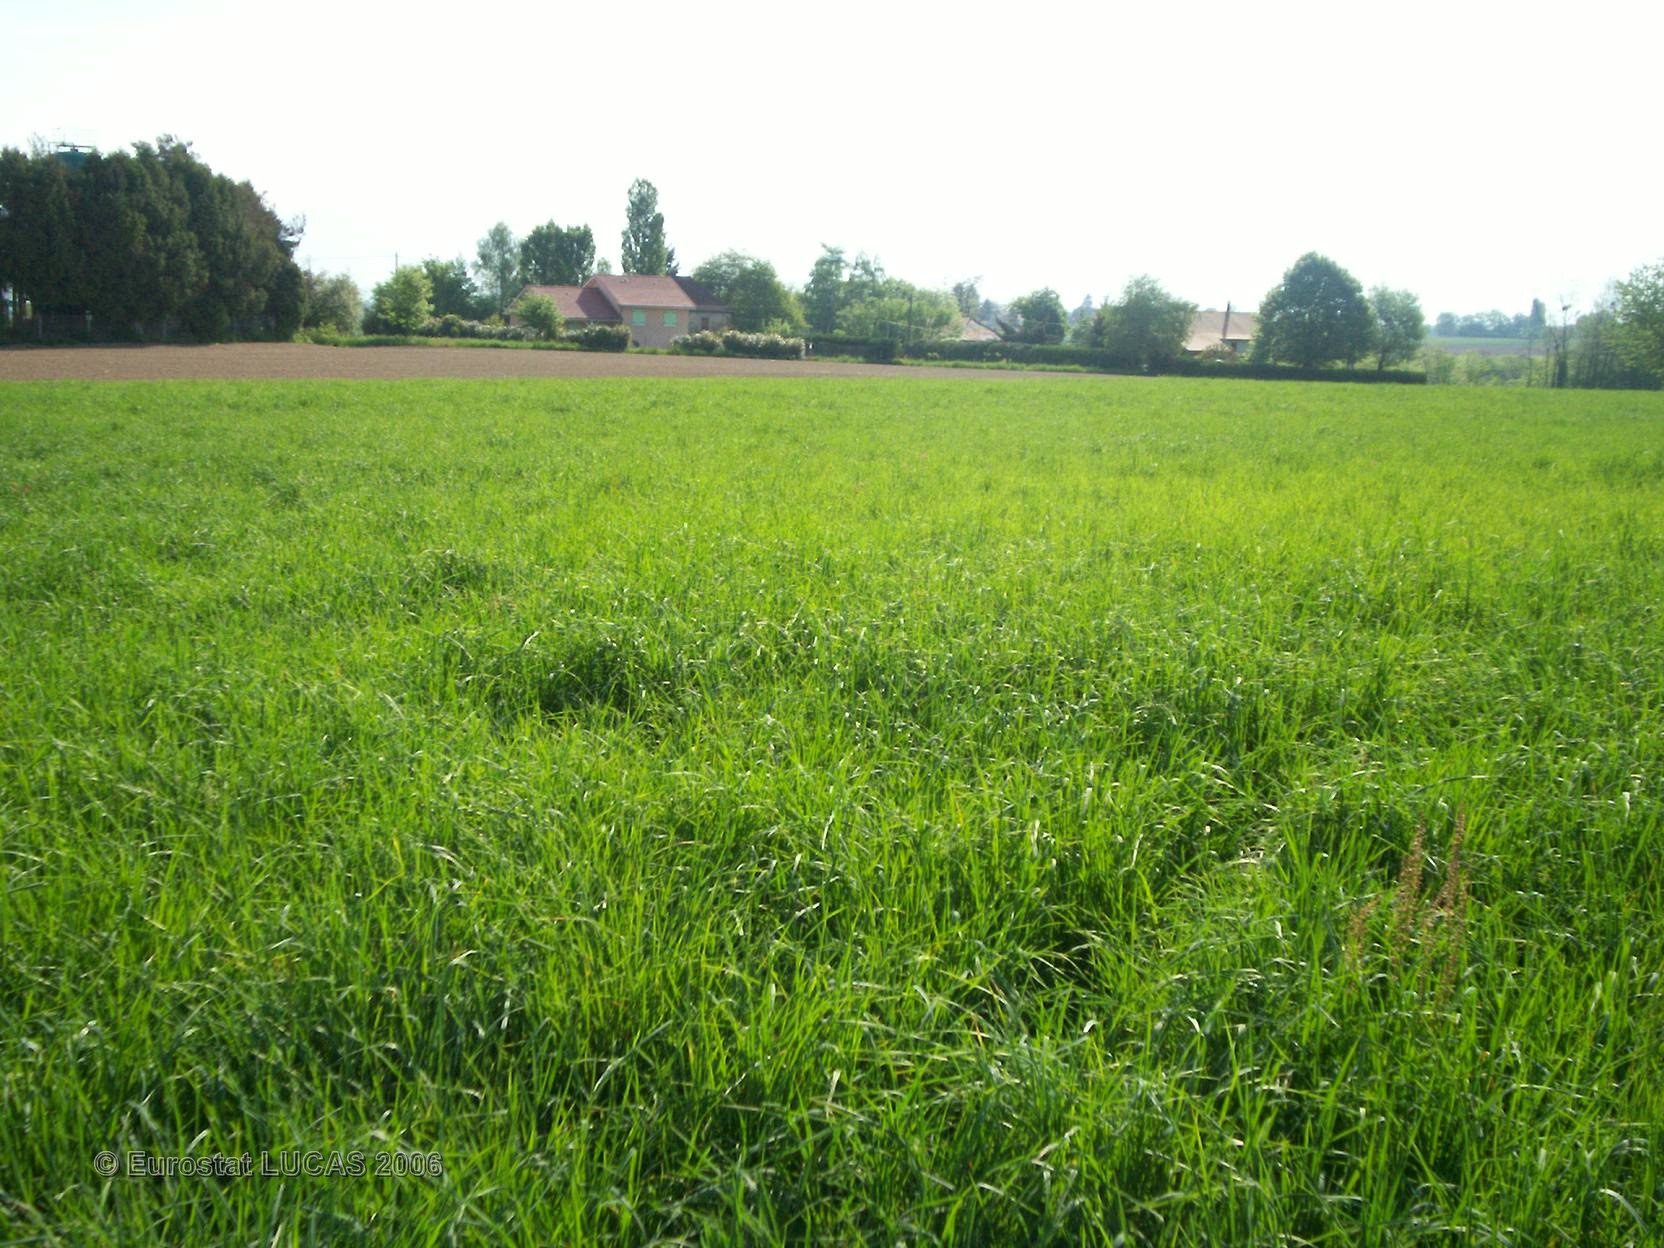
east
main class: Grassland
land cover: Grassland without tree/shrub cover
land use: Agriculture (excluding fallow land and kitchen gardens)
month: May
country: FR
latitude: 45.6241
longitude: 5.4768
